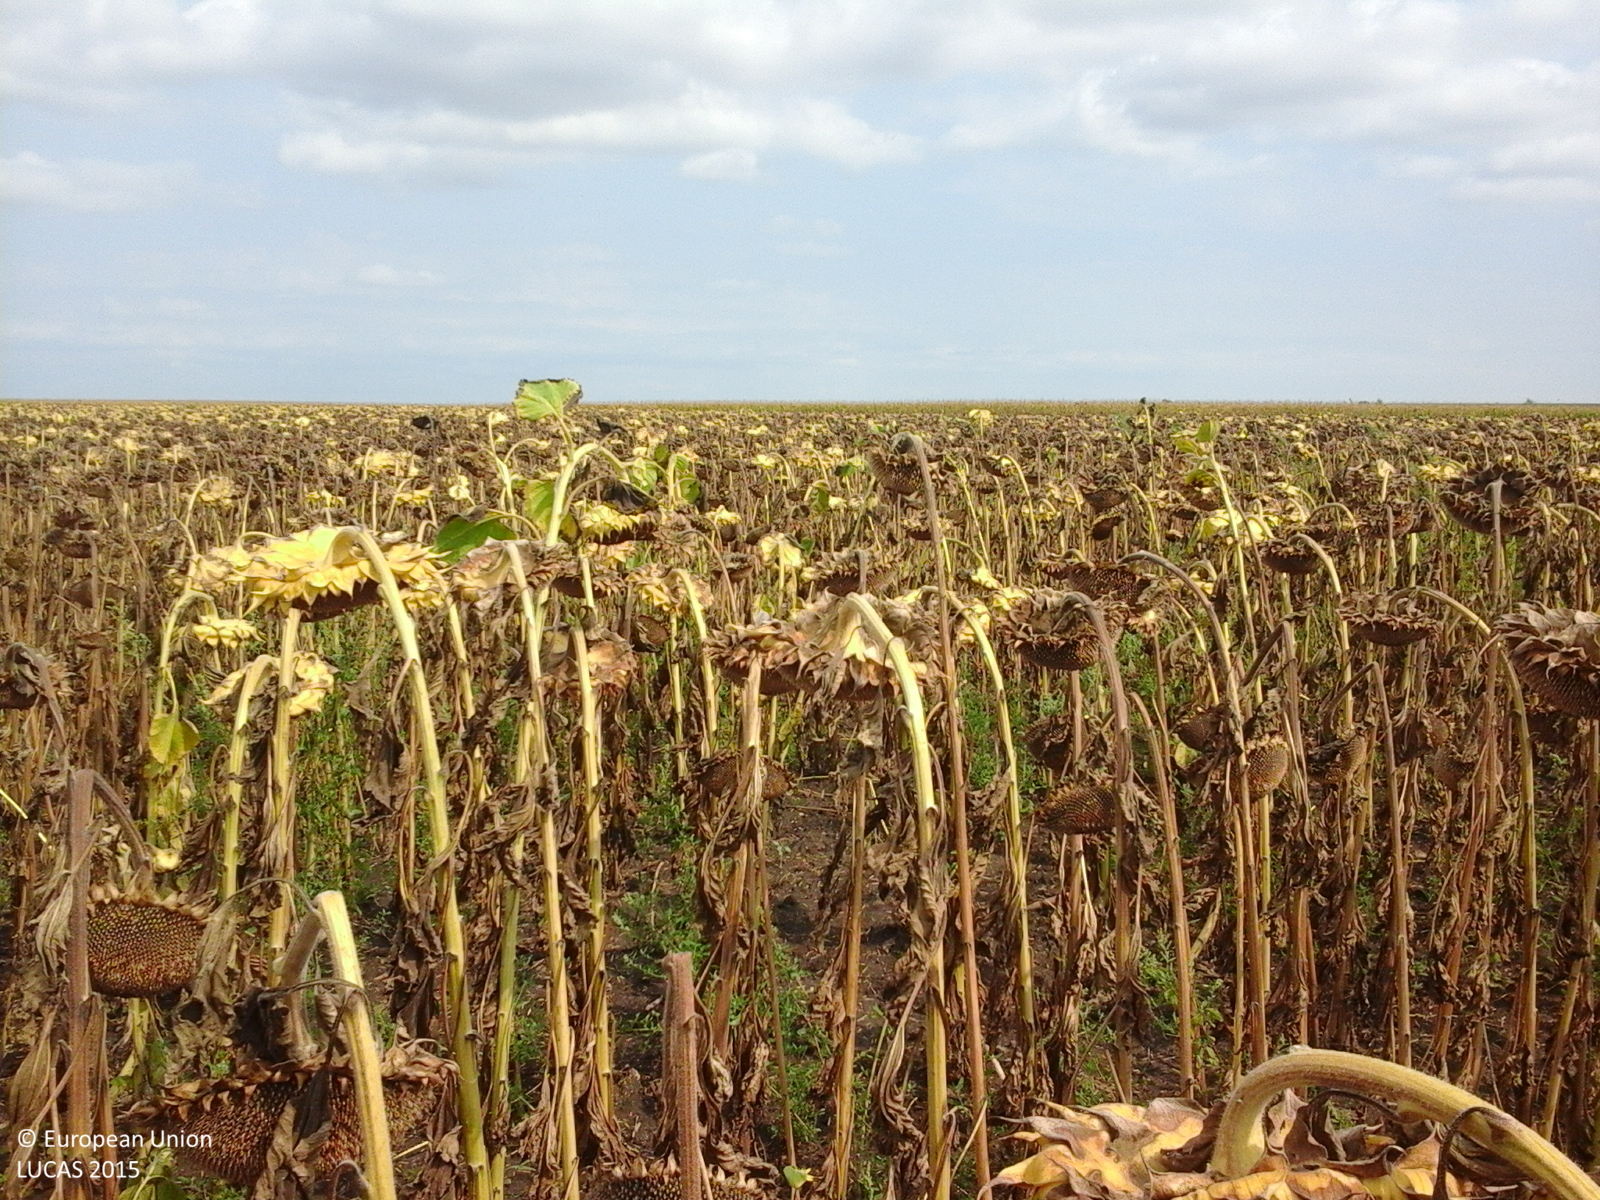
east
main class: Cropland
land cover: Sunflower
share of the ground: > 75 %
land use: Agriculture (excluding fallow land and kitchen gardens)
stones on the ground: < 10 %
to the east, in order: Sunflower; Common wheat; Maize
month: August
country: RO
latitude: 45.4796
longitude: 20.9383
